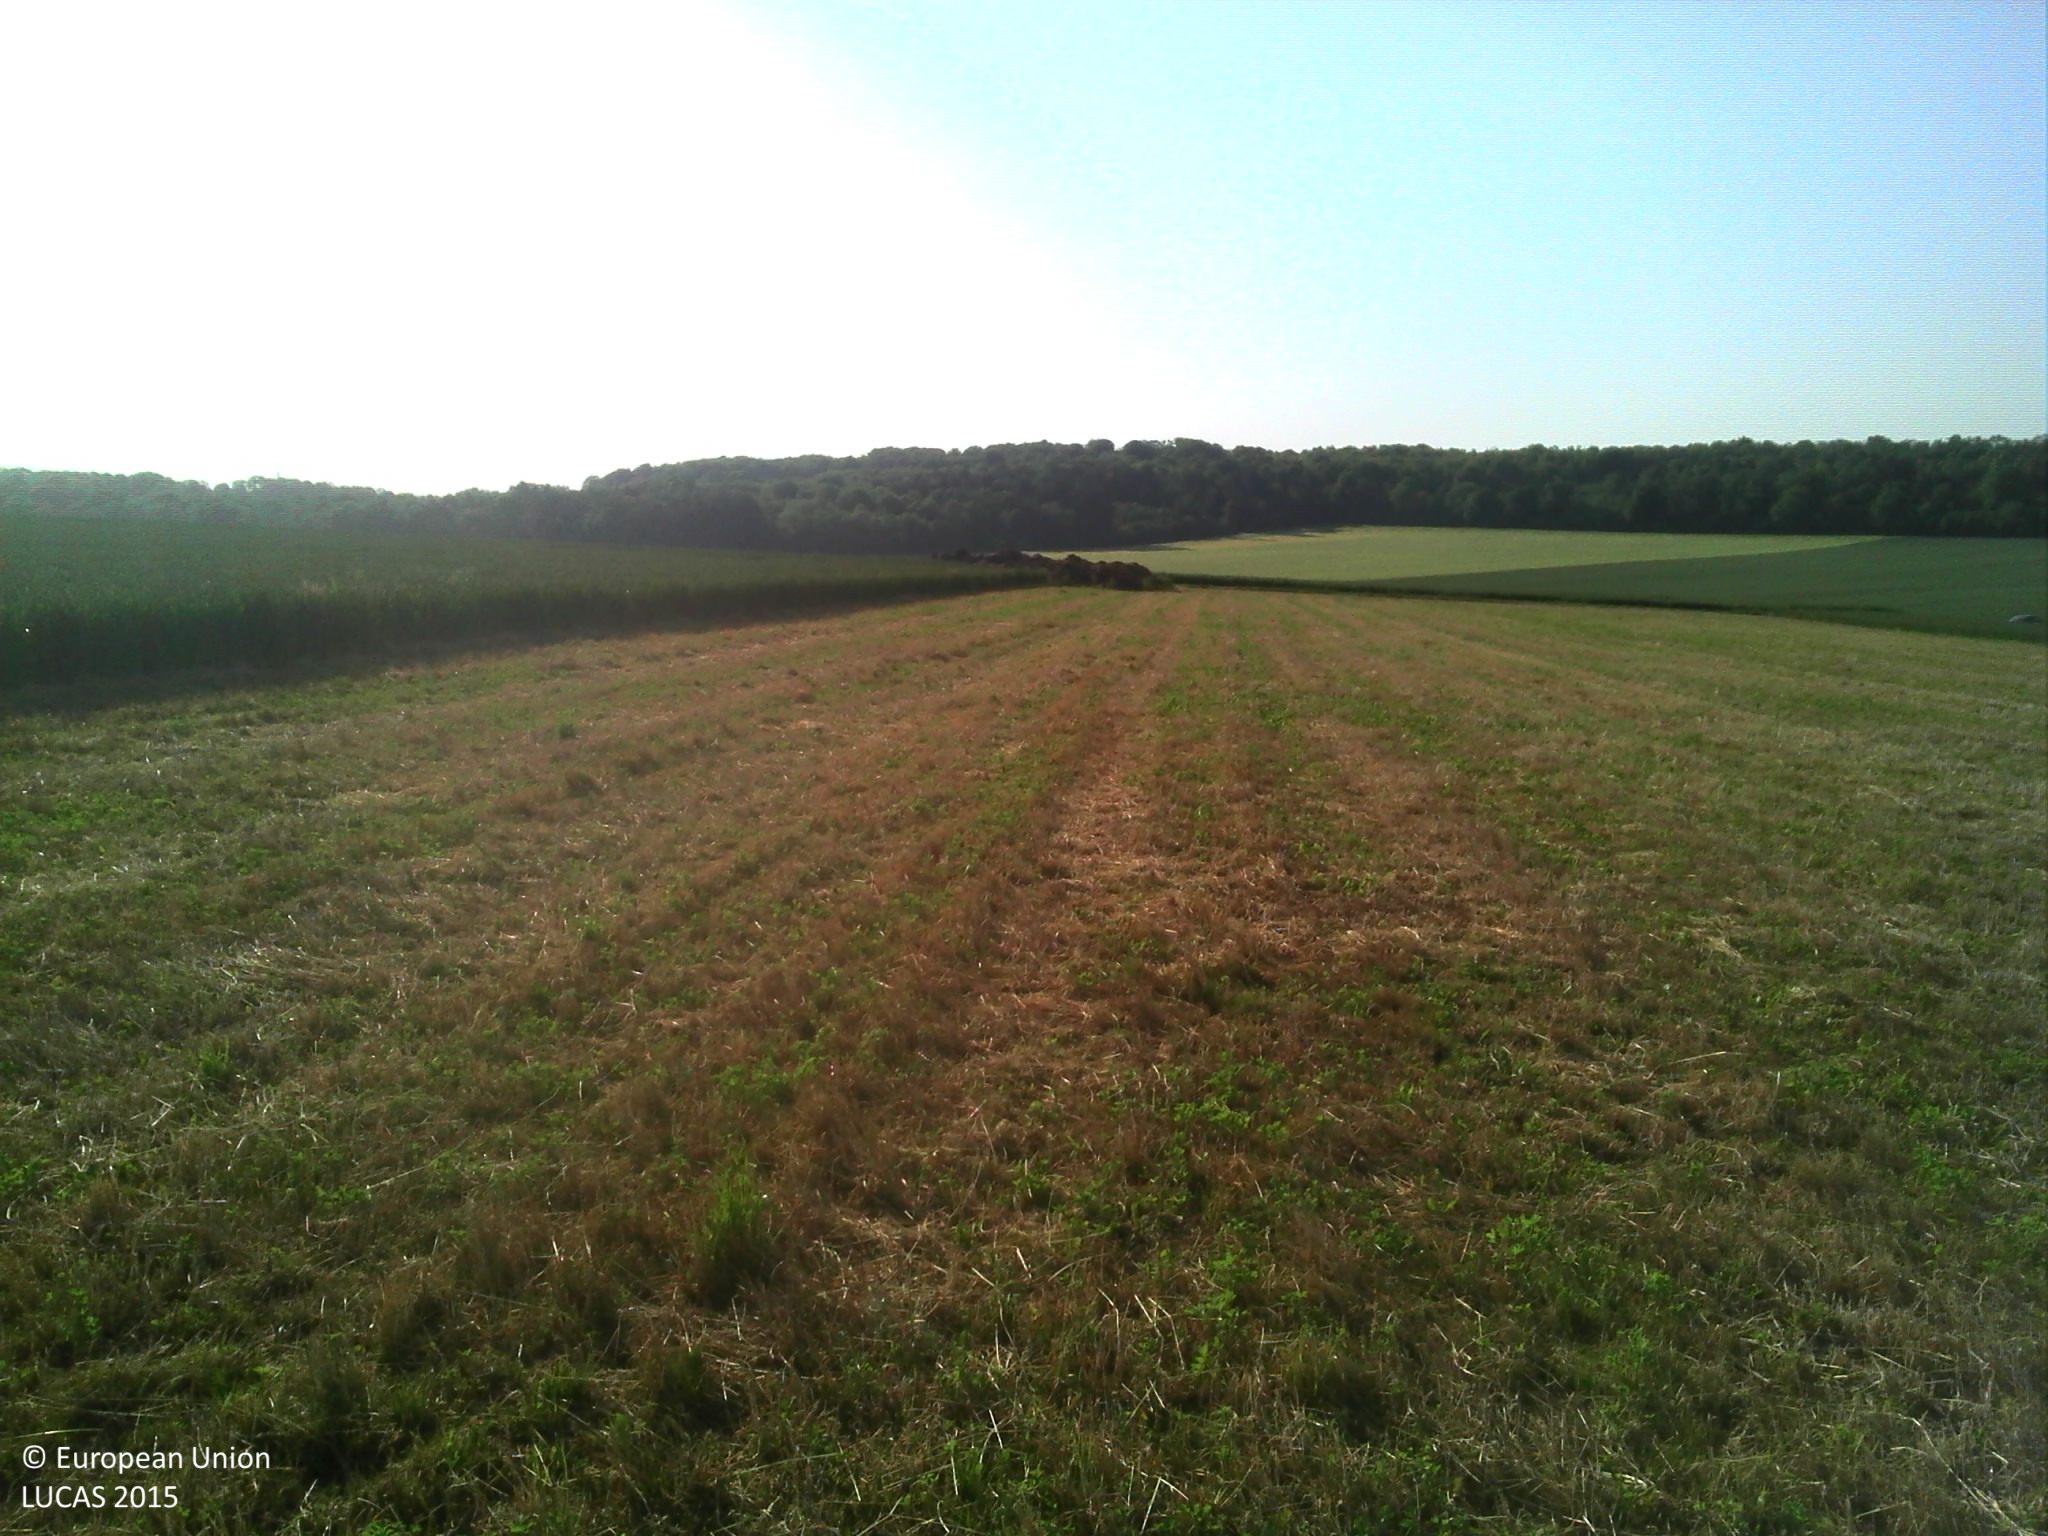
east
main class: Cropland
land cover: Lucerne
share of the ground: > 75 %
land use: Agriculture (excluding fallow land and kitchen gardens)
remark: Harvested field
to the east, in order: Lucerne; Common wheat; Grass margins; Tracks; Common wheat; Rape and turnip rape
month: June
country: FR
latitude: 49.8435
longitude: 2.1846
